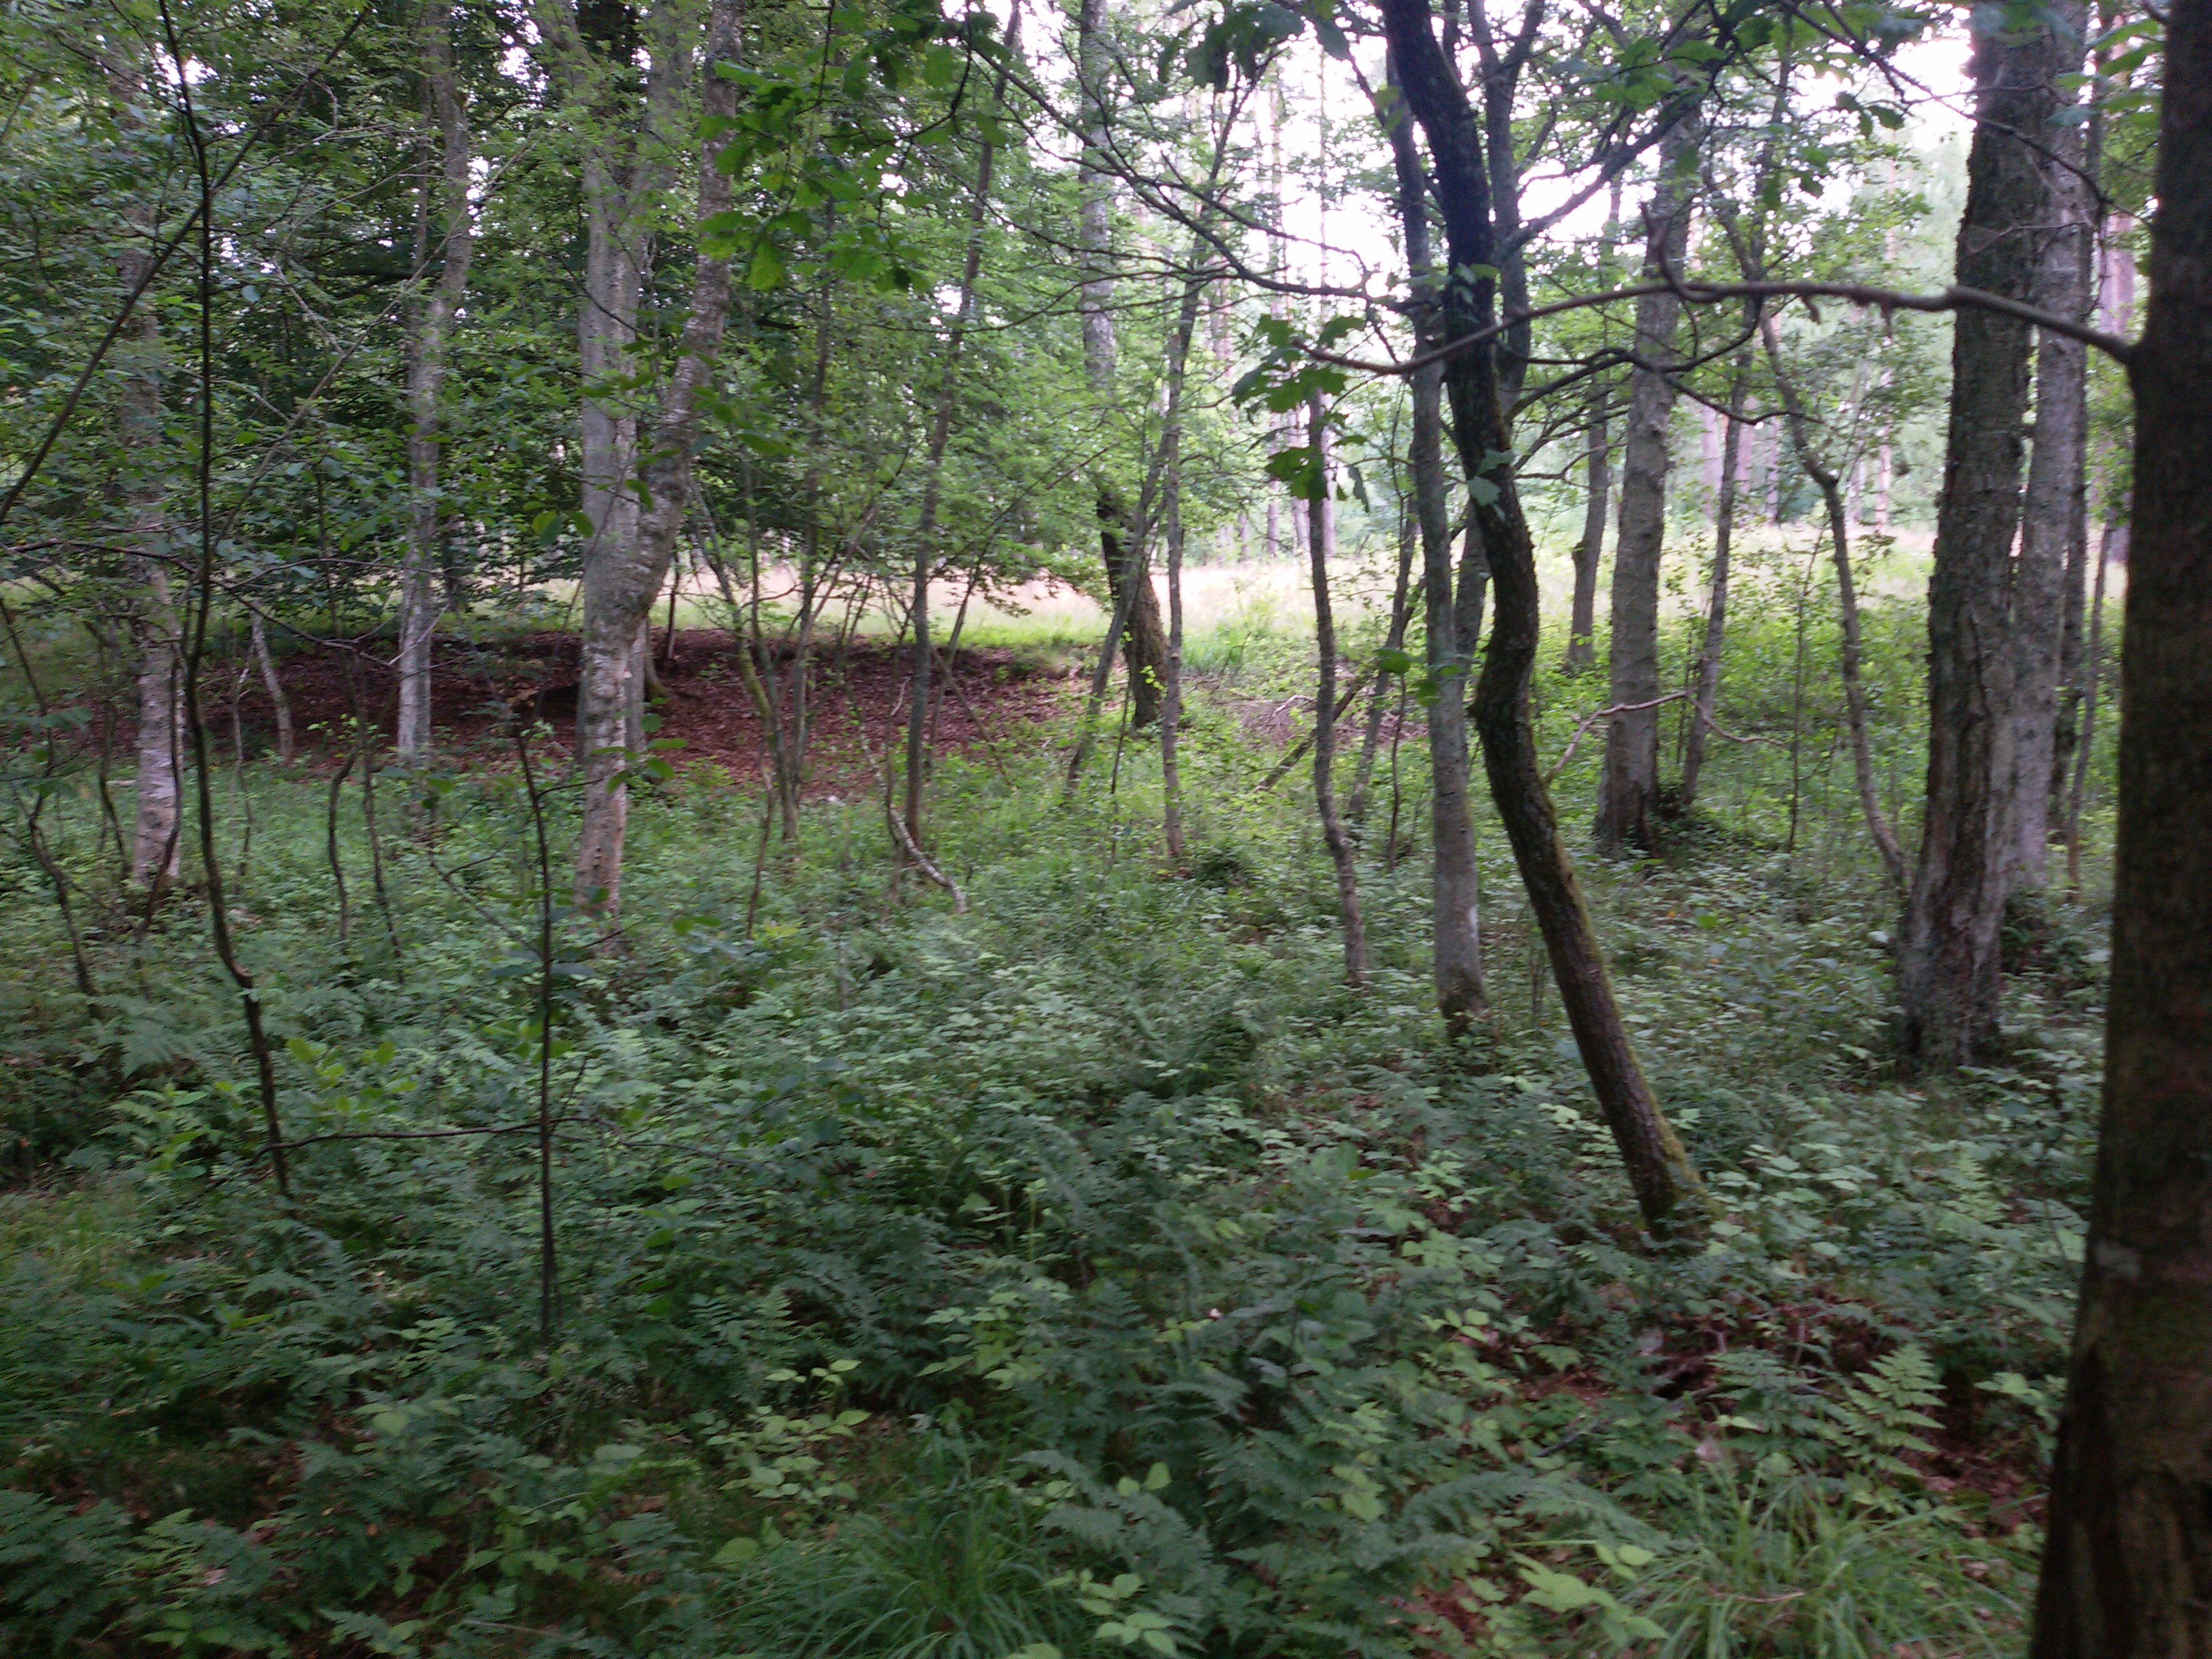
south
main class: Woodland
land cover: Broadleaved woodland
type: mesophytic deciduous forest
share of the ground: > 75 %
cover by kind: broadleaved forest trees 90 %, shrubs 5 %, herbaceous plants 5 %
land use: Forestry
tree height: > 5 m
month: July
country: PL
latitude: 53.8206
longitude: 15.8219
